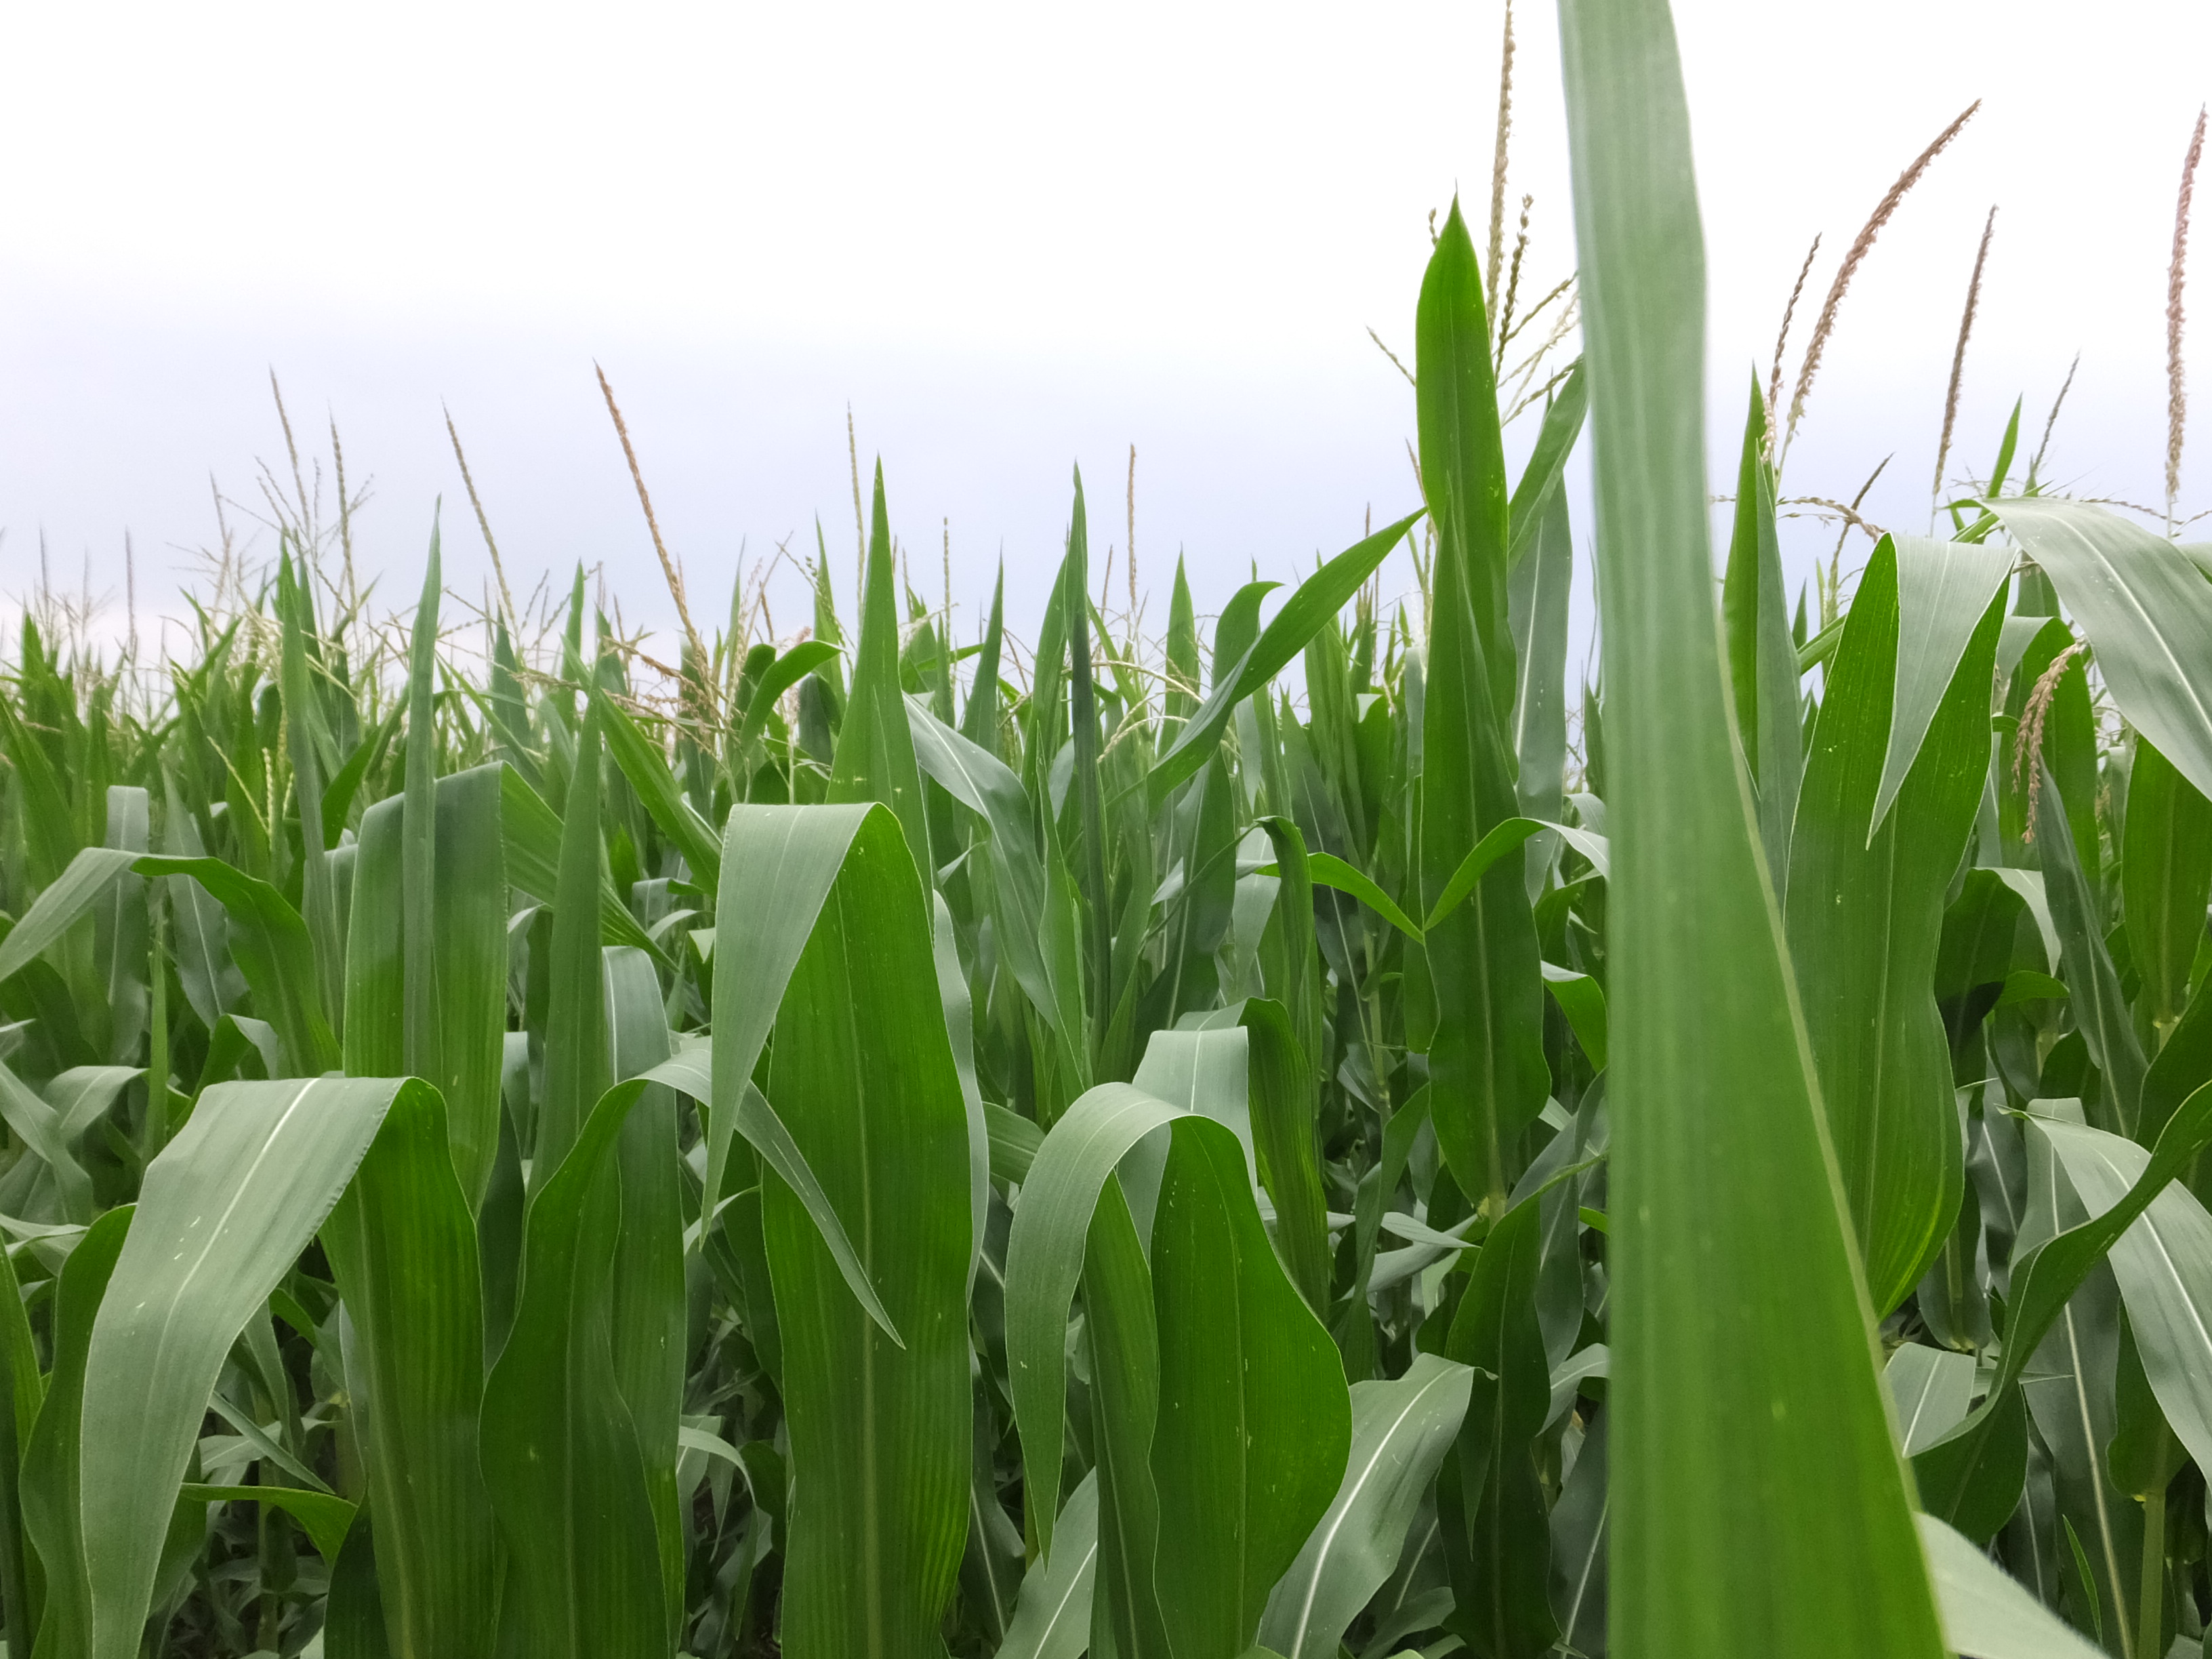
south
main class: Cropland
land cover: Maize
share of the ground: > 75 %
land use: Agriculture (excluding fallow land and kitchen gardens)
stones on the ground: < 10 %
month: July
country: ES
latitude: 41.4762
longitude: -0.0859
